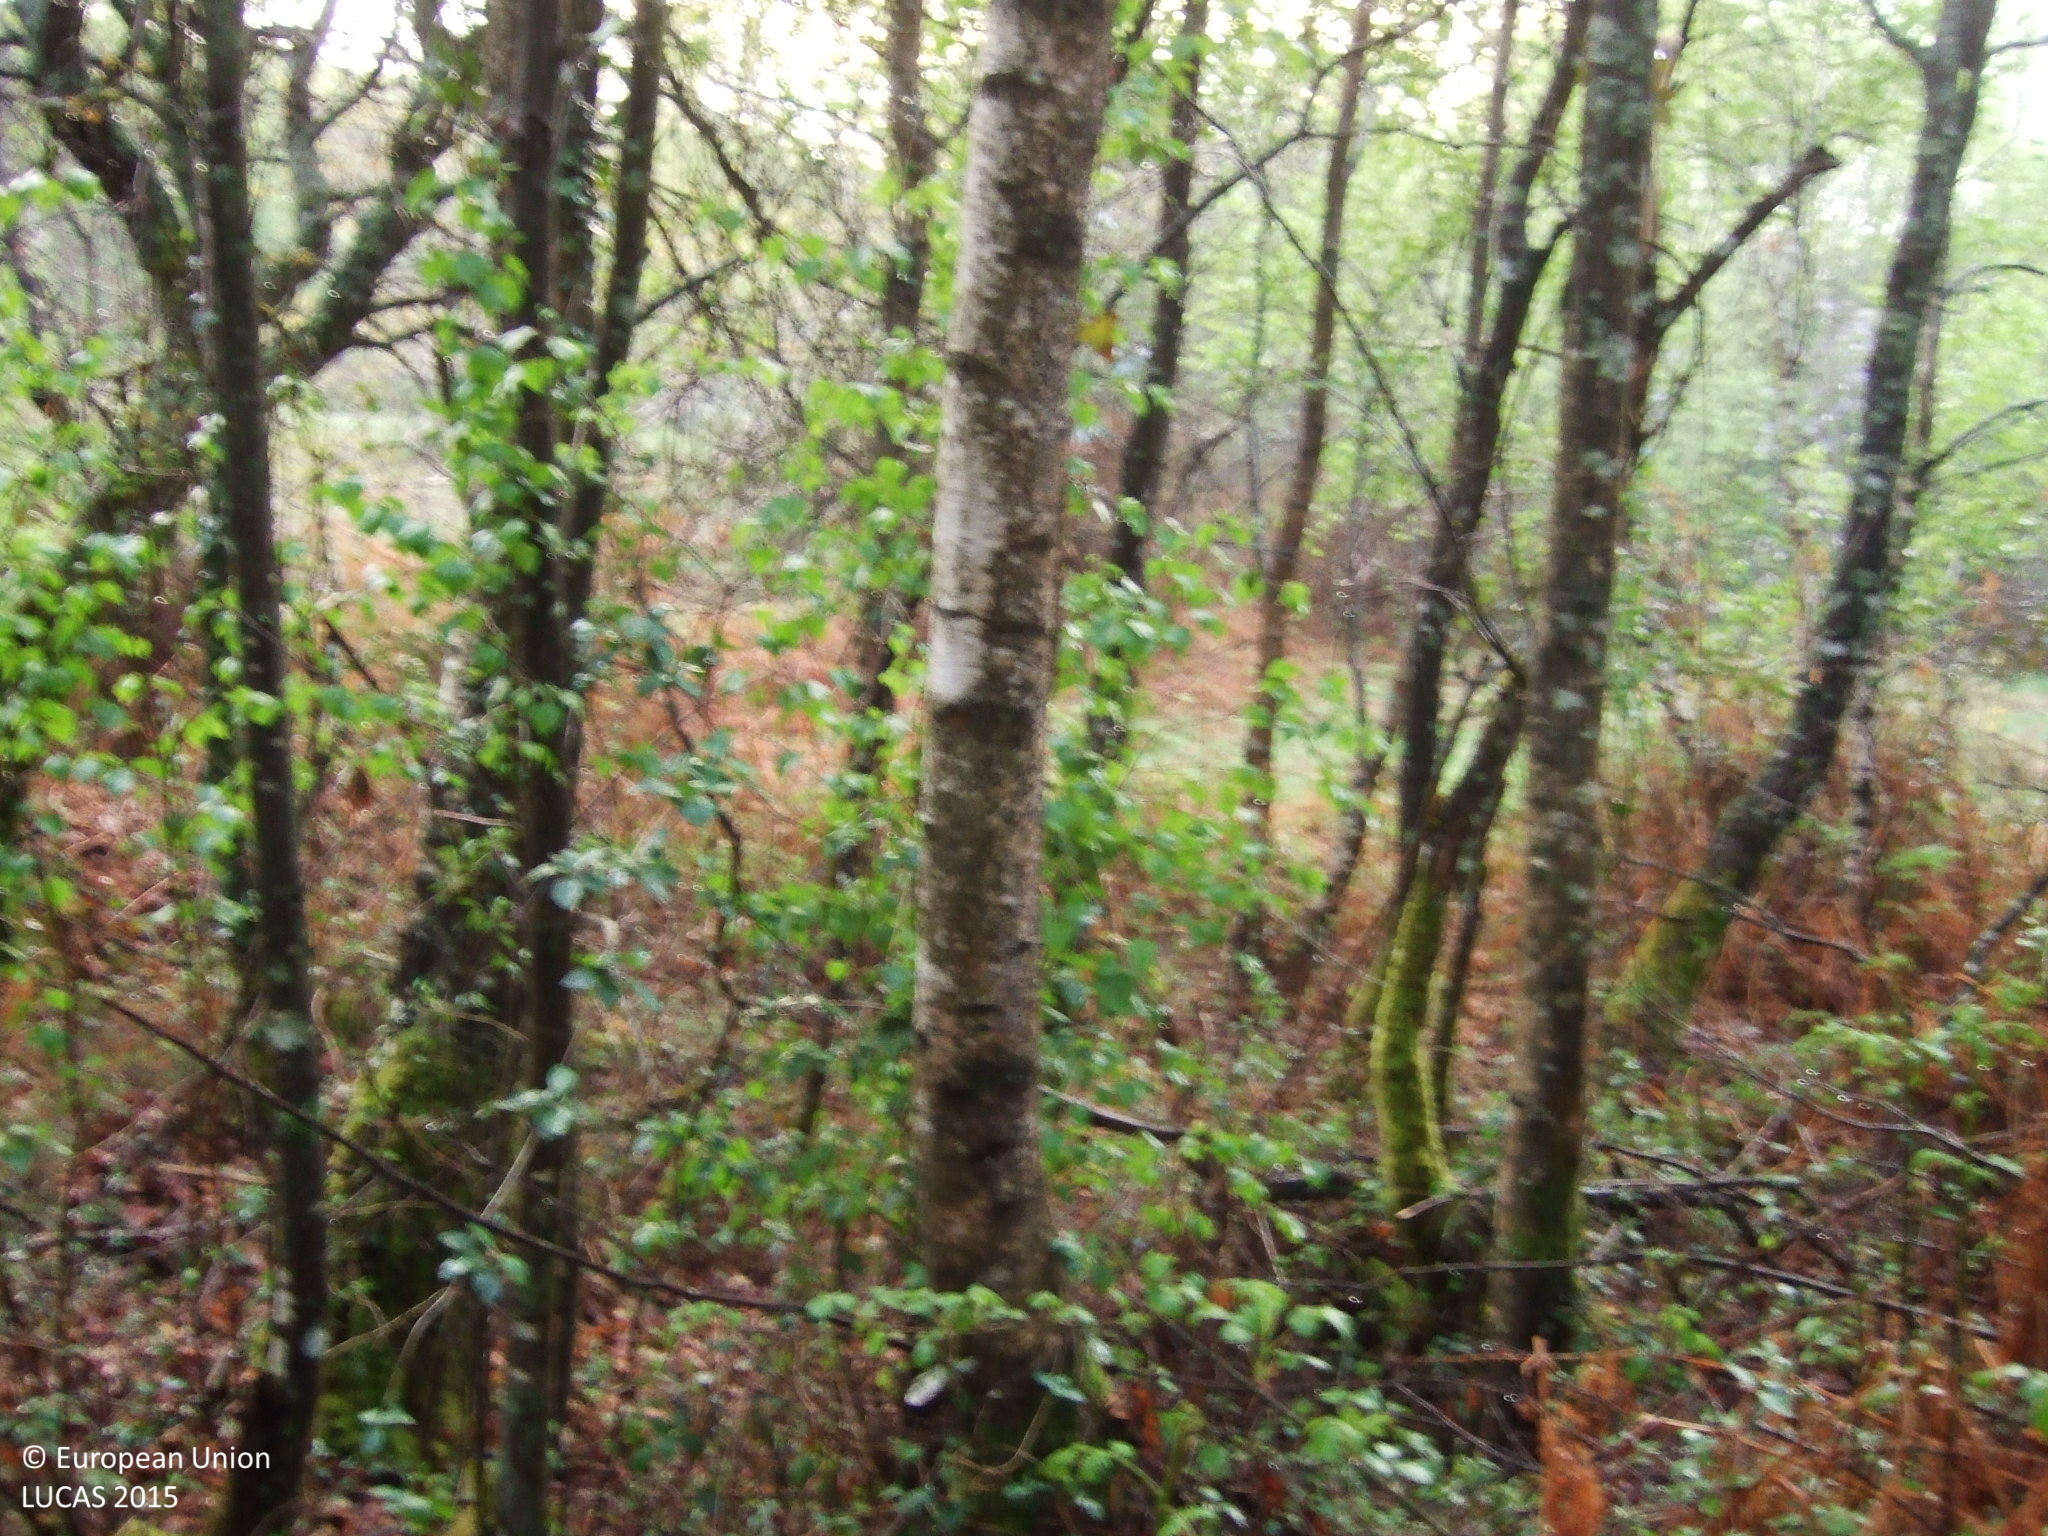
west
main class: Woodland
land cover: Broadleaved woodland
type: acidophilous oak and oak-birch forest
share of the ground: > 75 %
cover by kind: broadleaved forest trees 90 %, shrubs 10 %
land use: Forestry
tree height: > 5 m
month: April
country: ES
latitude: 42.9289
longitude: -7.3592
